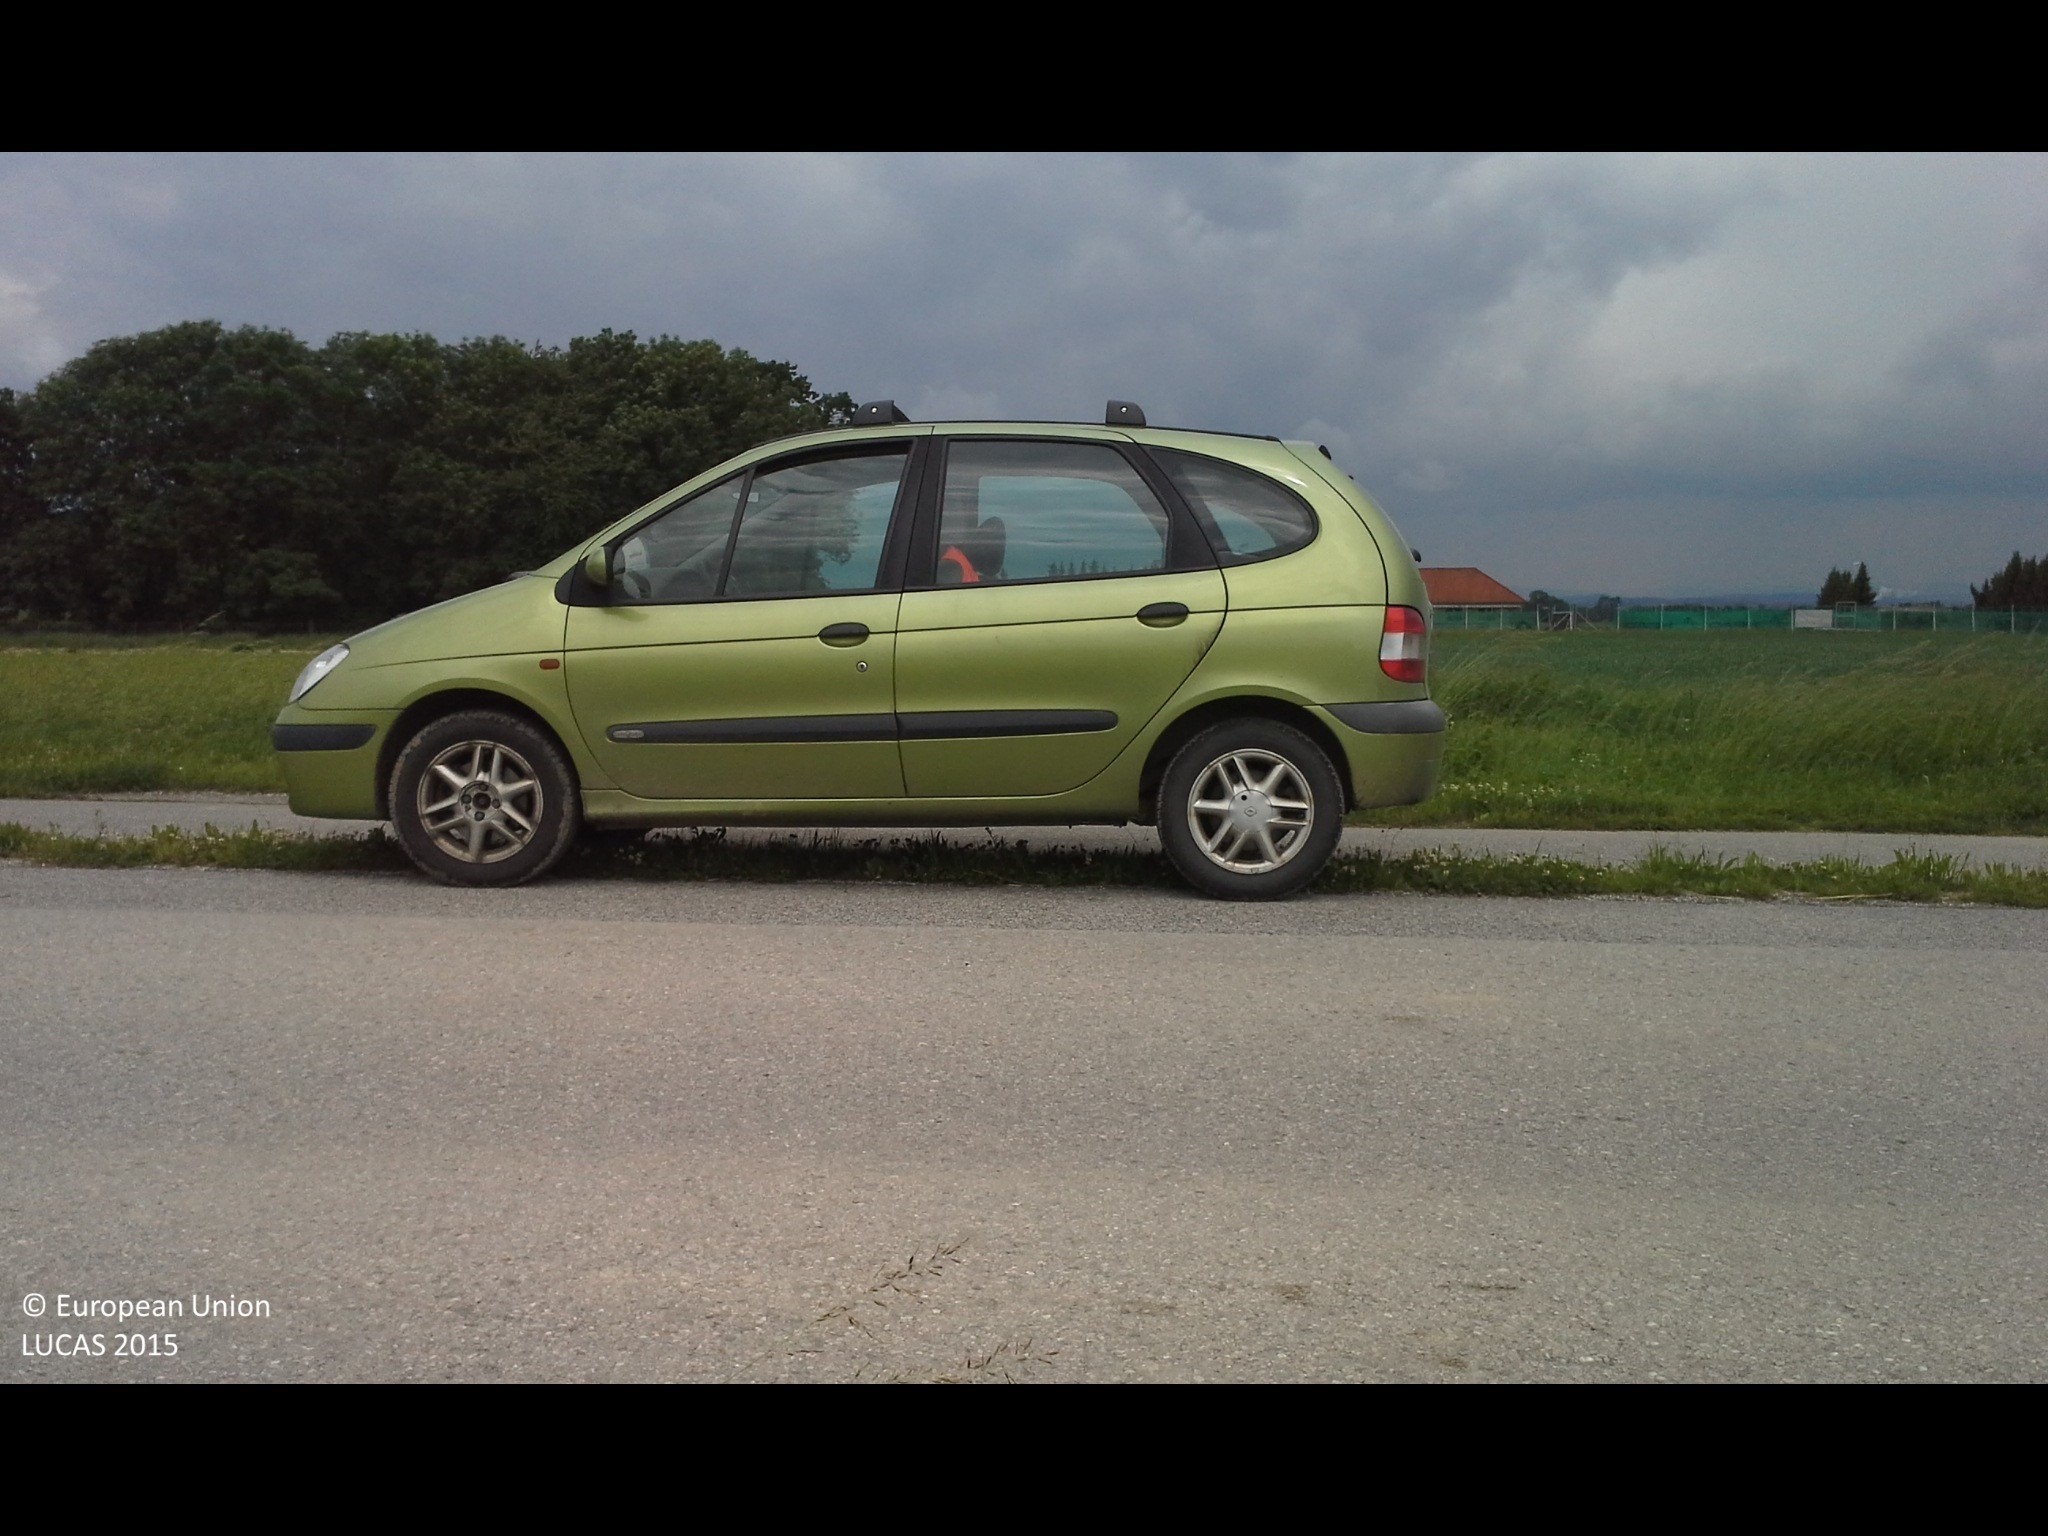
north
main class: Cropland
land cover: Soya
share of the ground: 10 - 25 %
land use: Agriculture (excluding fallow land and kitchen gardens)
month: May
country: AT
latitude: 48.1676
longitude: 14.5047
